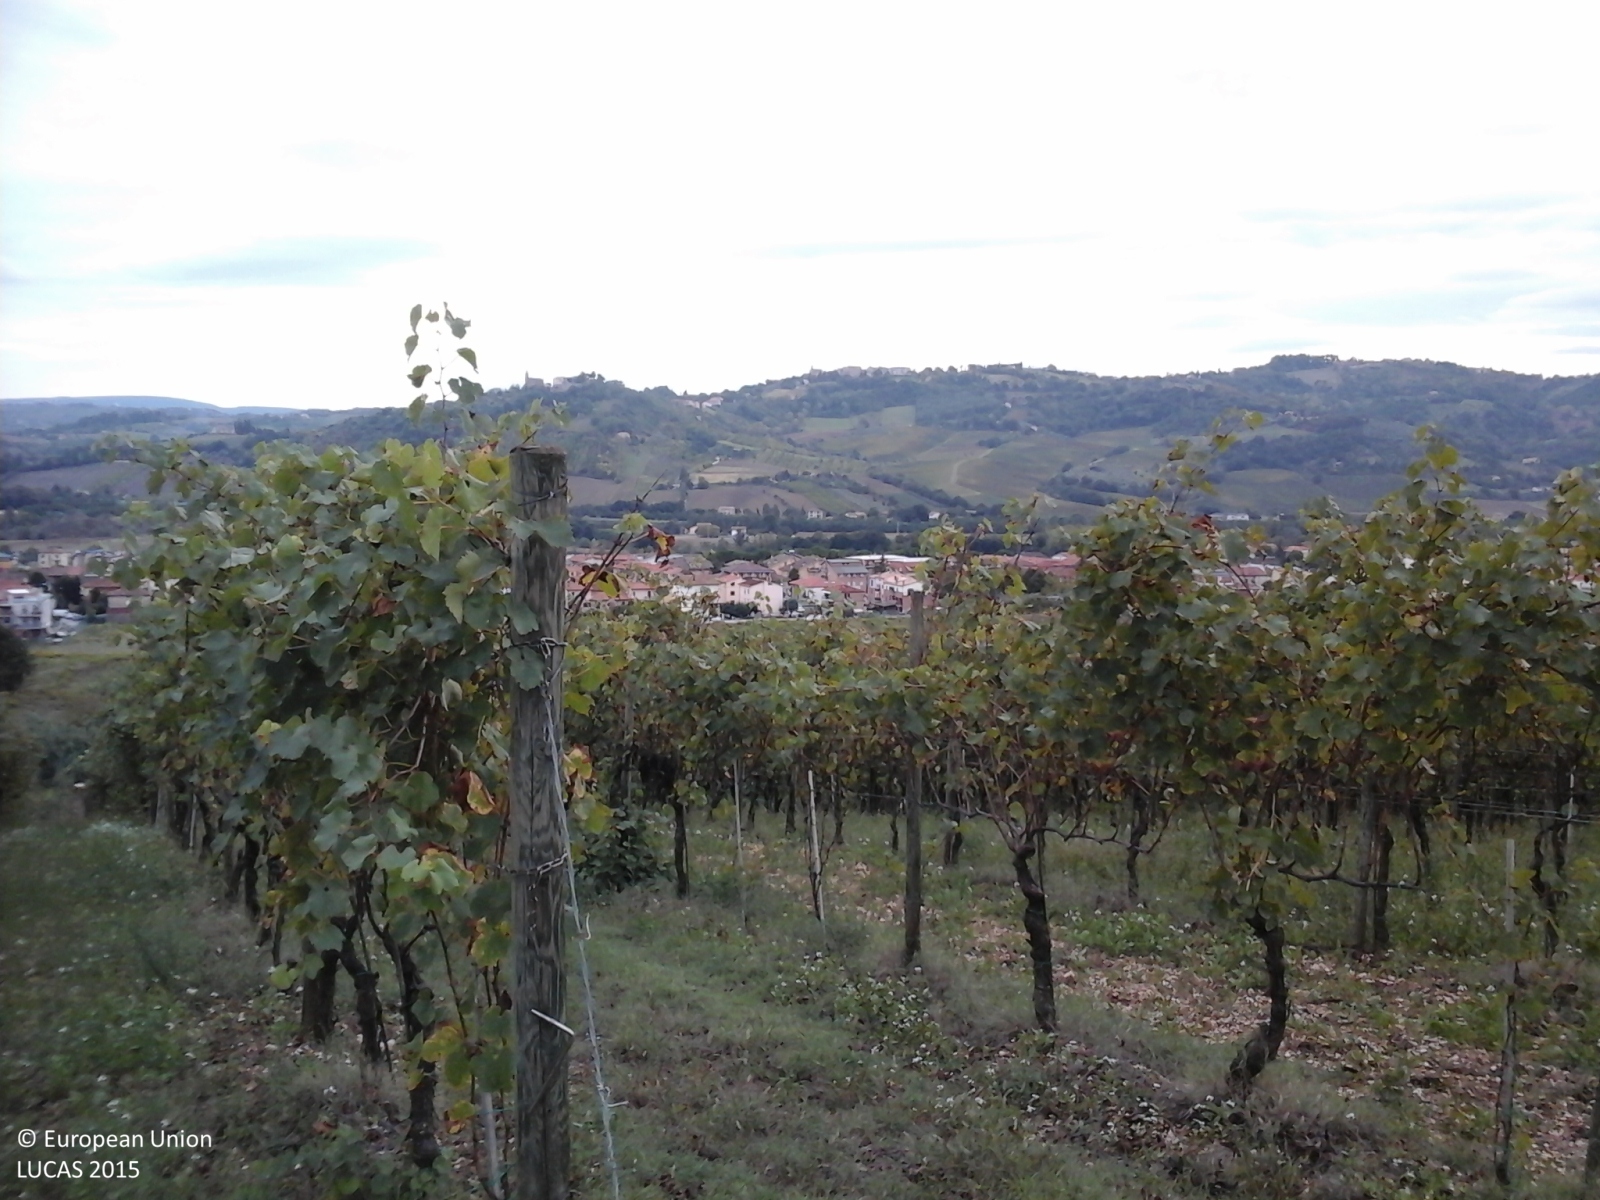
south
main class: Grassland
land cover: Grassland without tree/shrub cover
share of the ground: 25 - 50 %
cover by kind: herbaceous plants 100 %
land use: Agriculture (excluding fallow land and kitchen gardens)
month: October
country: IT
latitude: 43.5085
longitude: 13.1463
